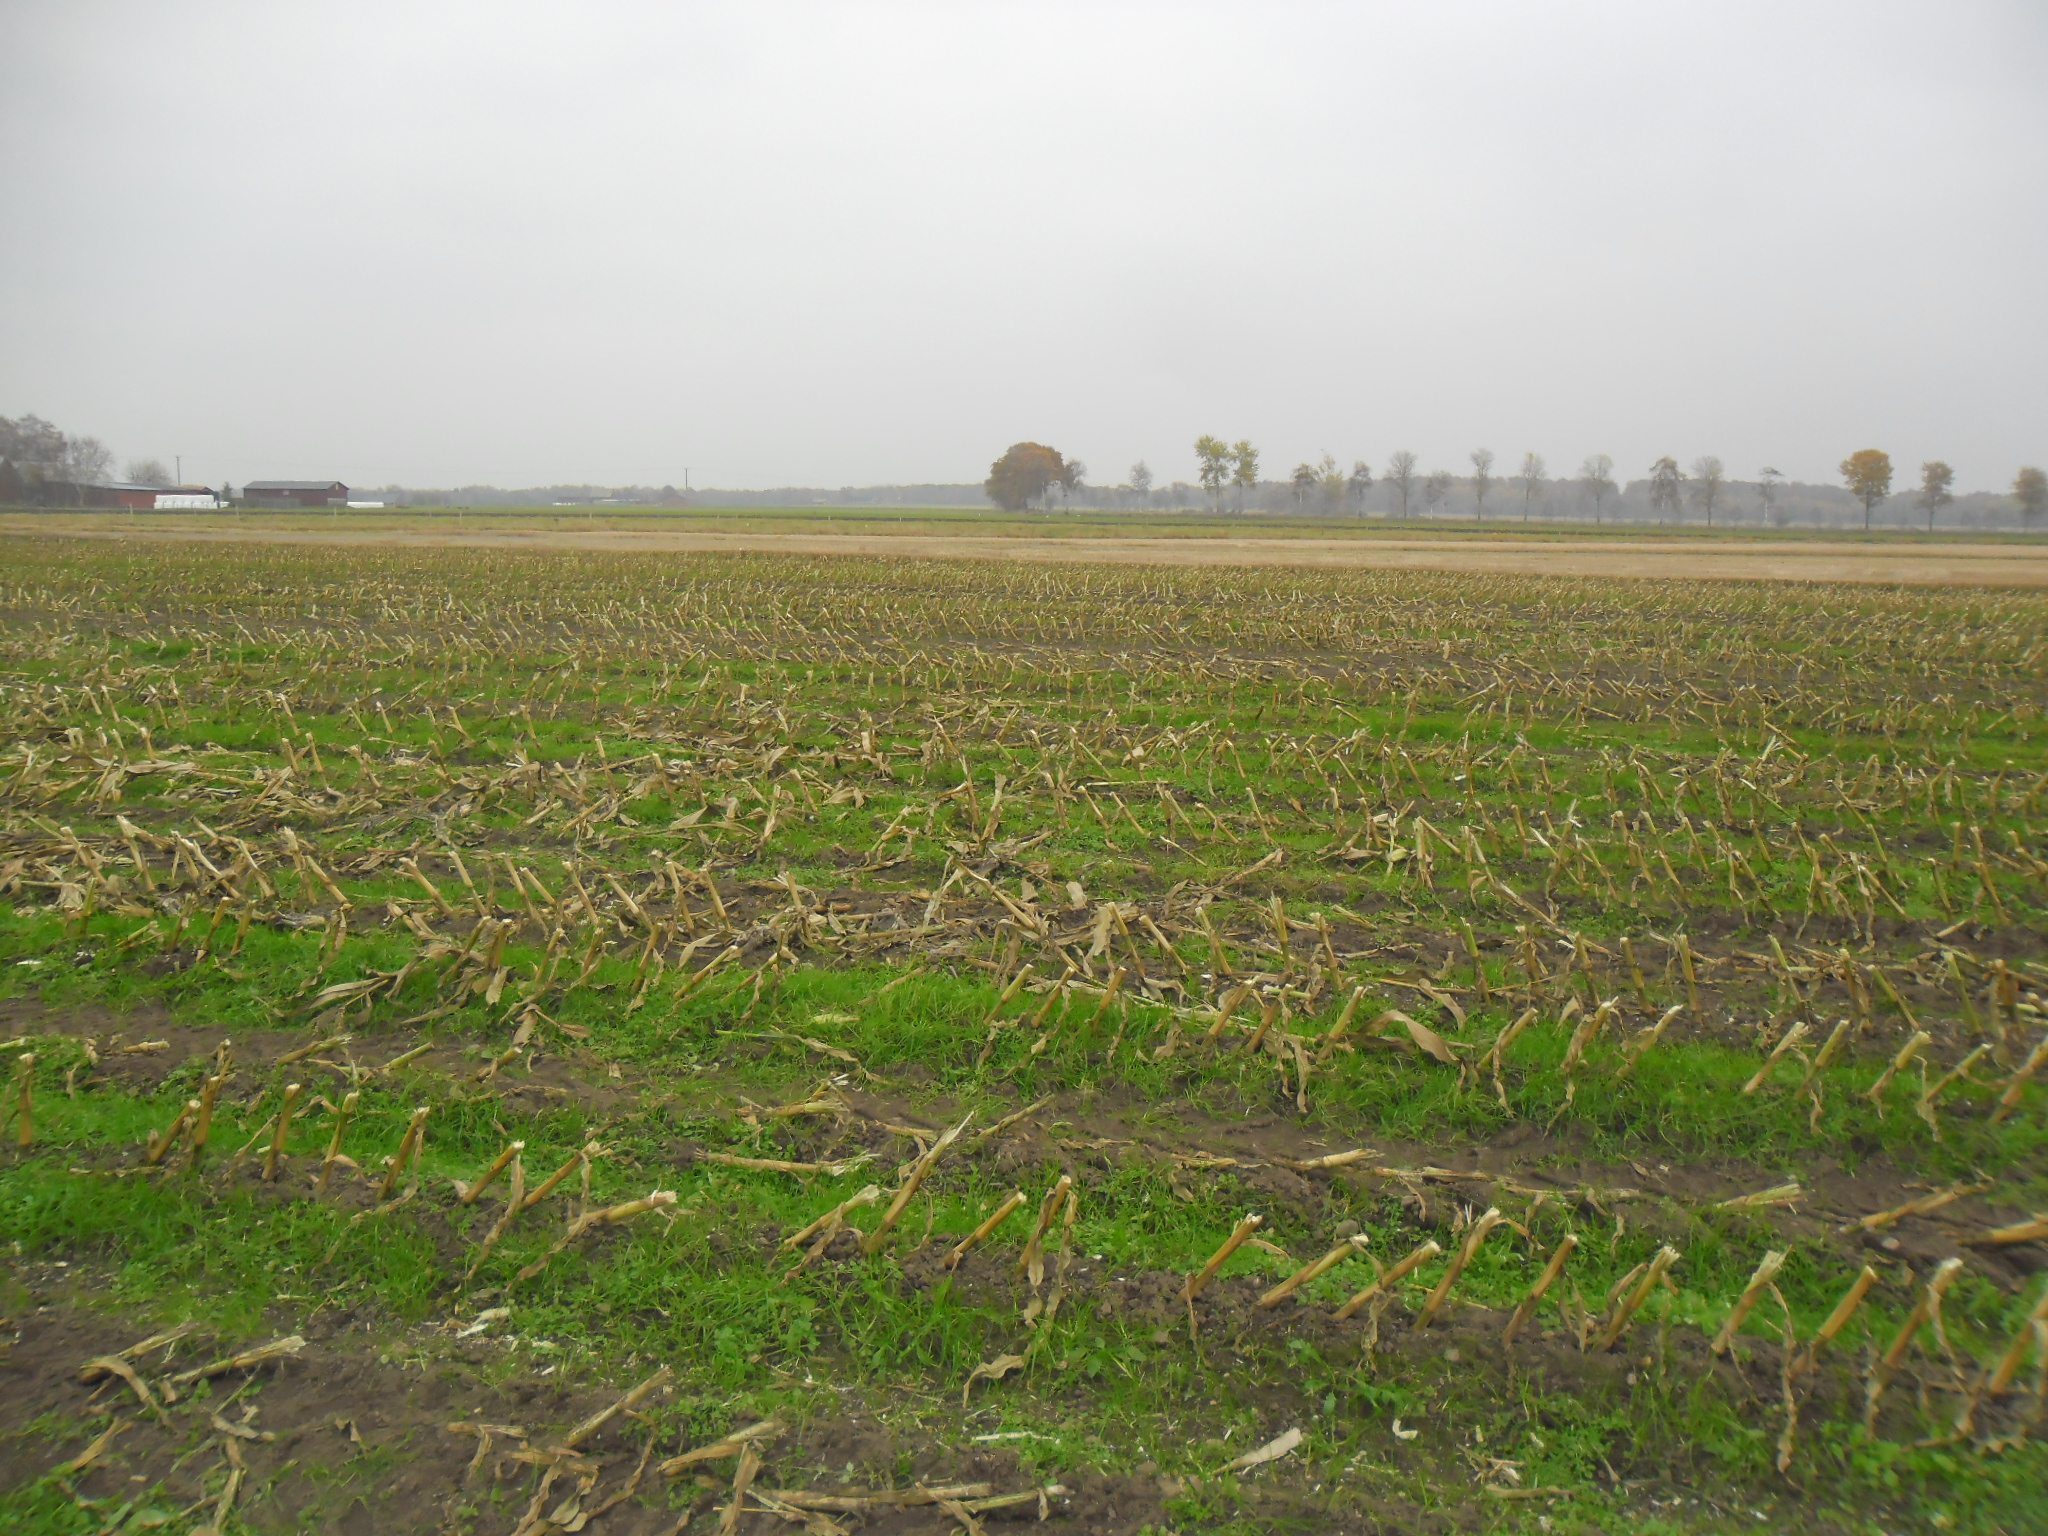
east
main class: Cropland
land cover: Maize
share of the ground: < 10 %
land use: Agriculture (excluding fallow land and kitchen gardens)
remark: Harvested field
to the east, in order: Maize; Common wheat; Tracks; Common wheat; Fences; Grassland without tree/shrub cover; Fences; Other bare soil; Grassland without tree/shrub cover
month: October
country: SE
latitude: 56.4383
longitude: 13.0949
